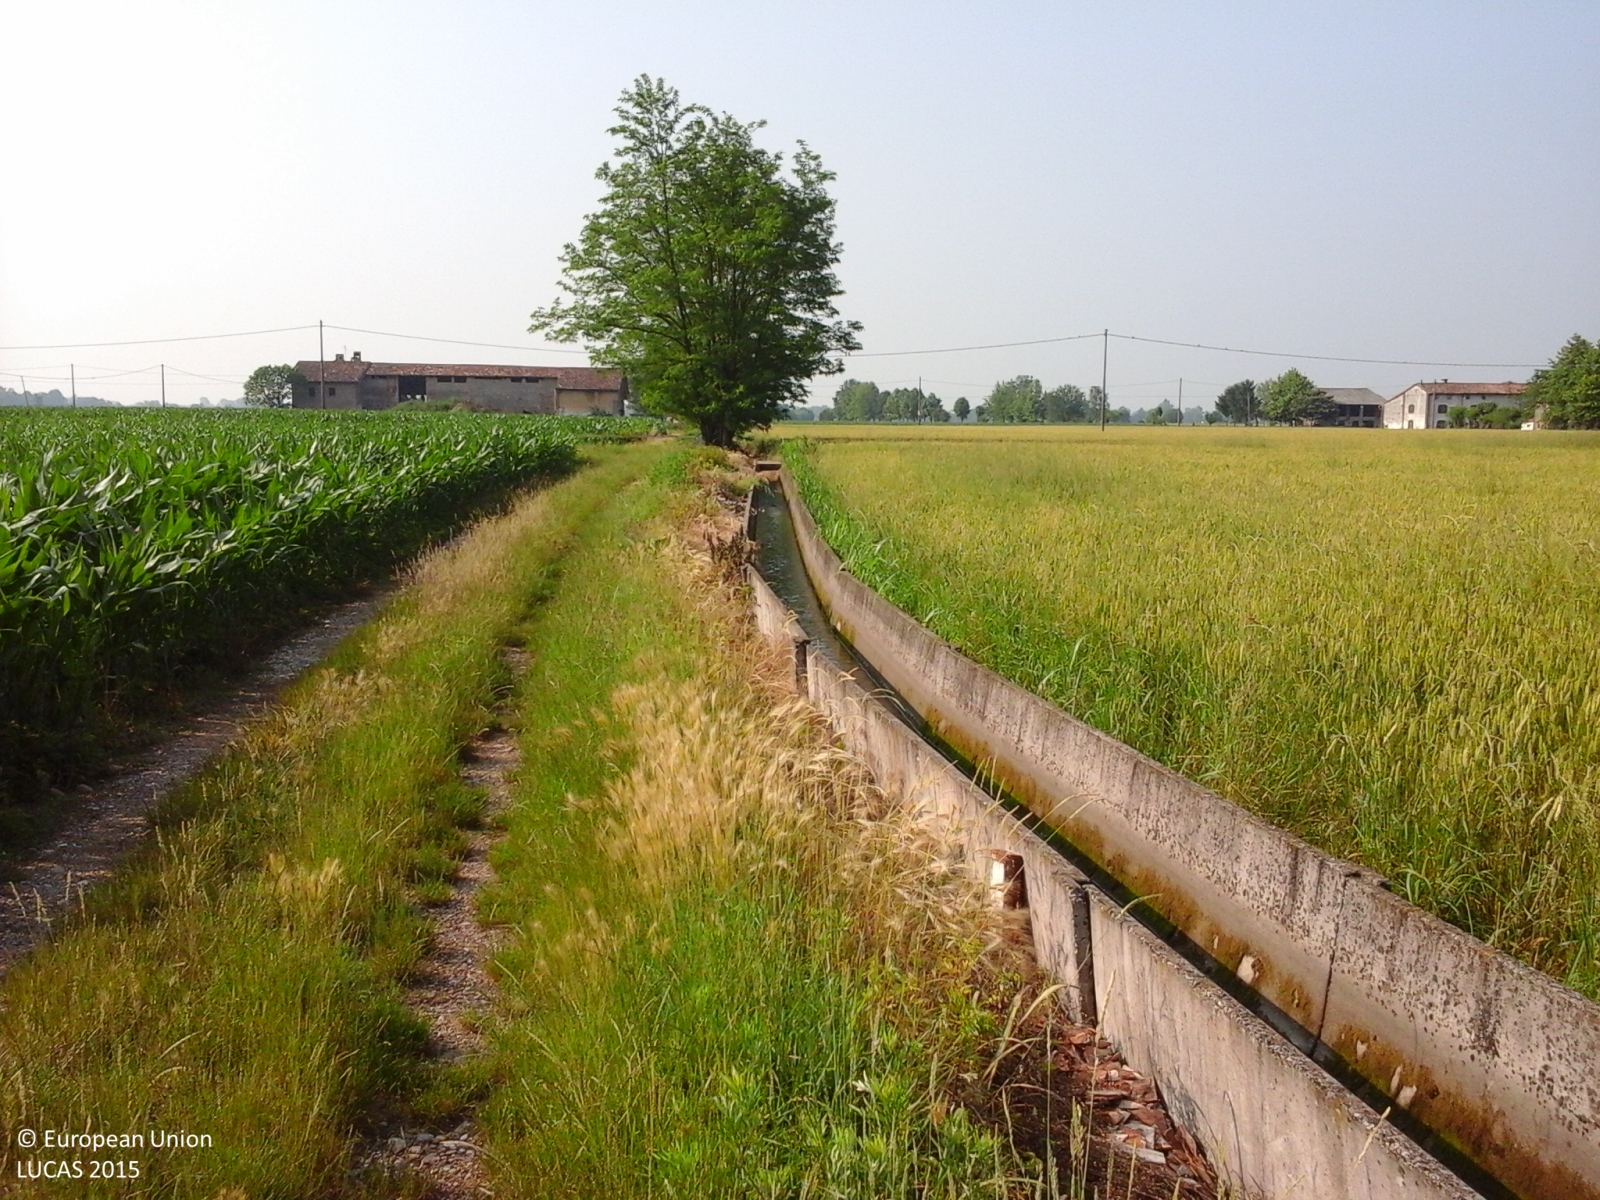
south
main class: Cropland
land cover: Common wheat
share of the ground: > 75 %
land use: Agriculture (excluding fallow land and kitchen gardens)
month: June
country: IT
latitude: 45.4683
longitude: 9.8595
